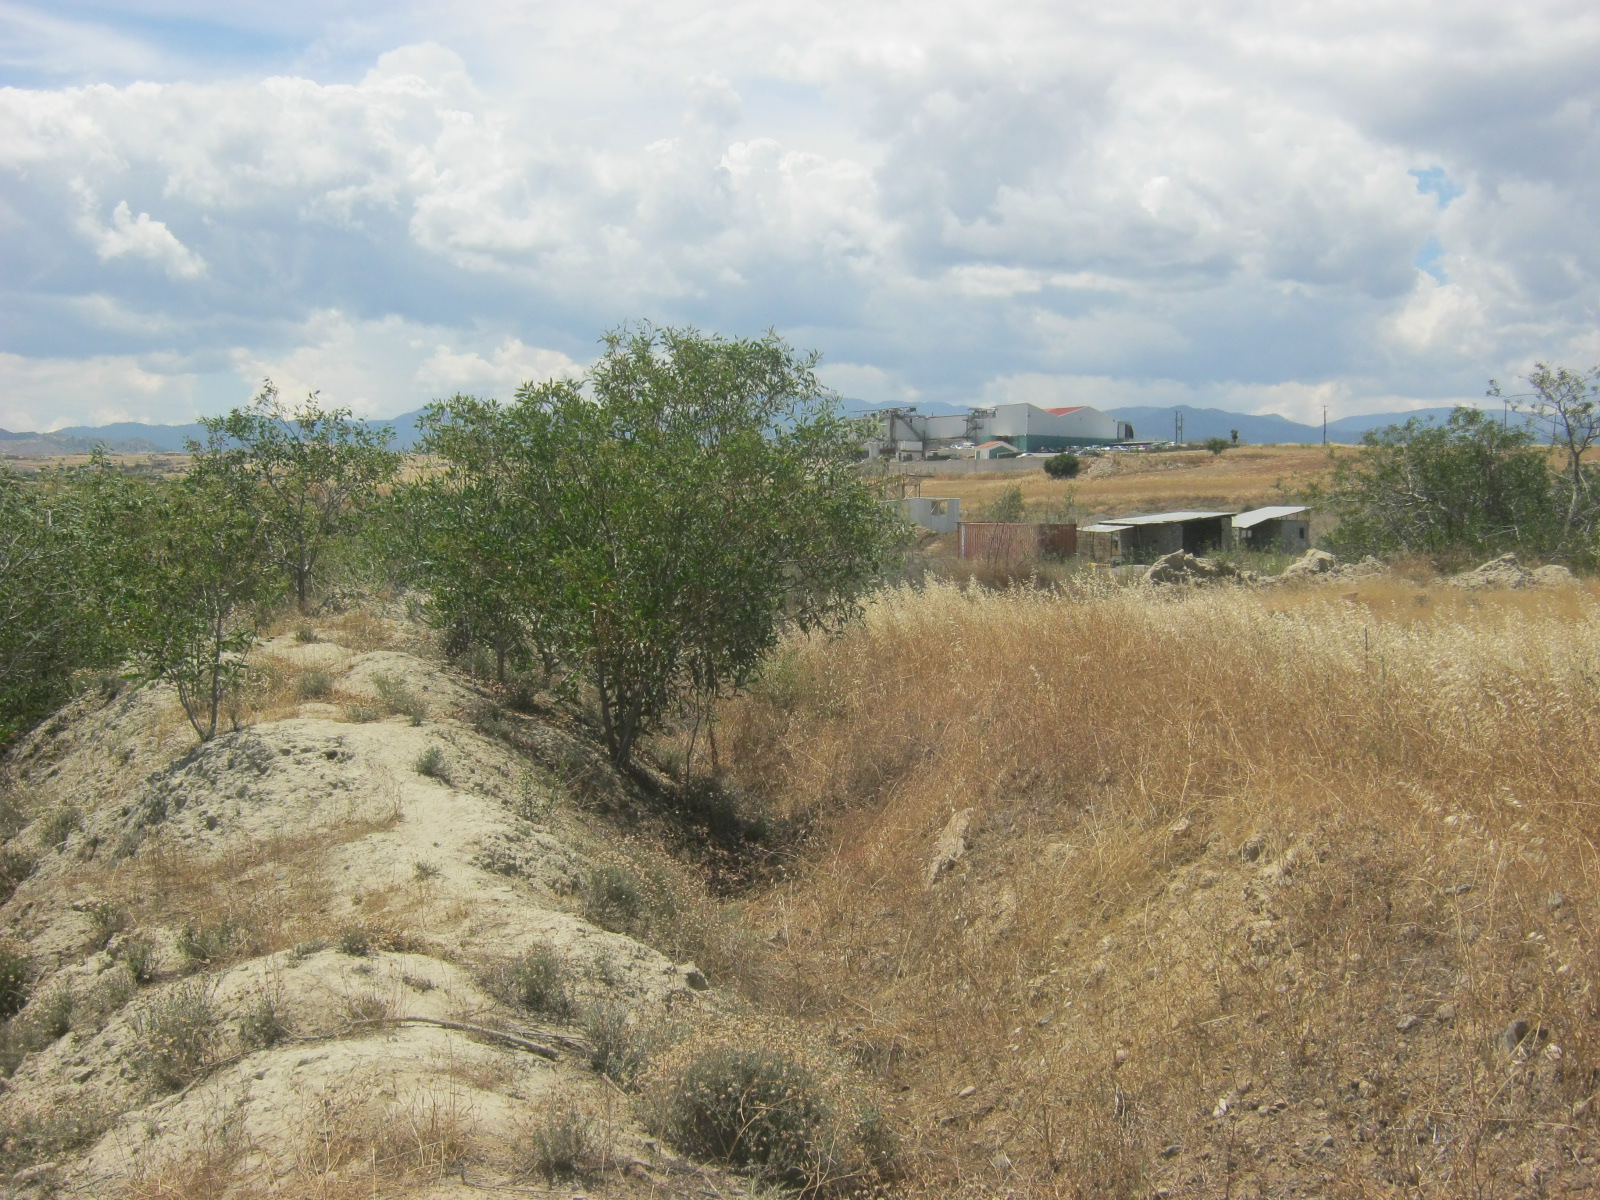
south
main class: Shrubland
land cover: Shrubland without tree cover
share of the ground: 50 - 75 %
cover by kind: herbaceous plants 55 %, unconsolidated bare surface 30 %, shrubs 15 %
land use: Semi-natural and natural areas not in use
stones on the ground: < 10 %
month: May
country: CY
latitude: 35.1276
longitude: 33.0152
